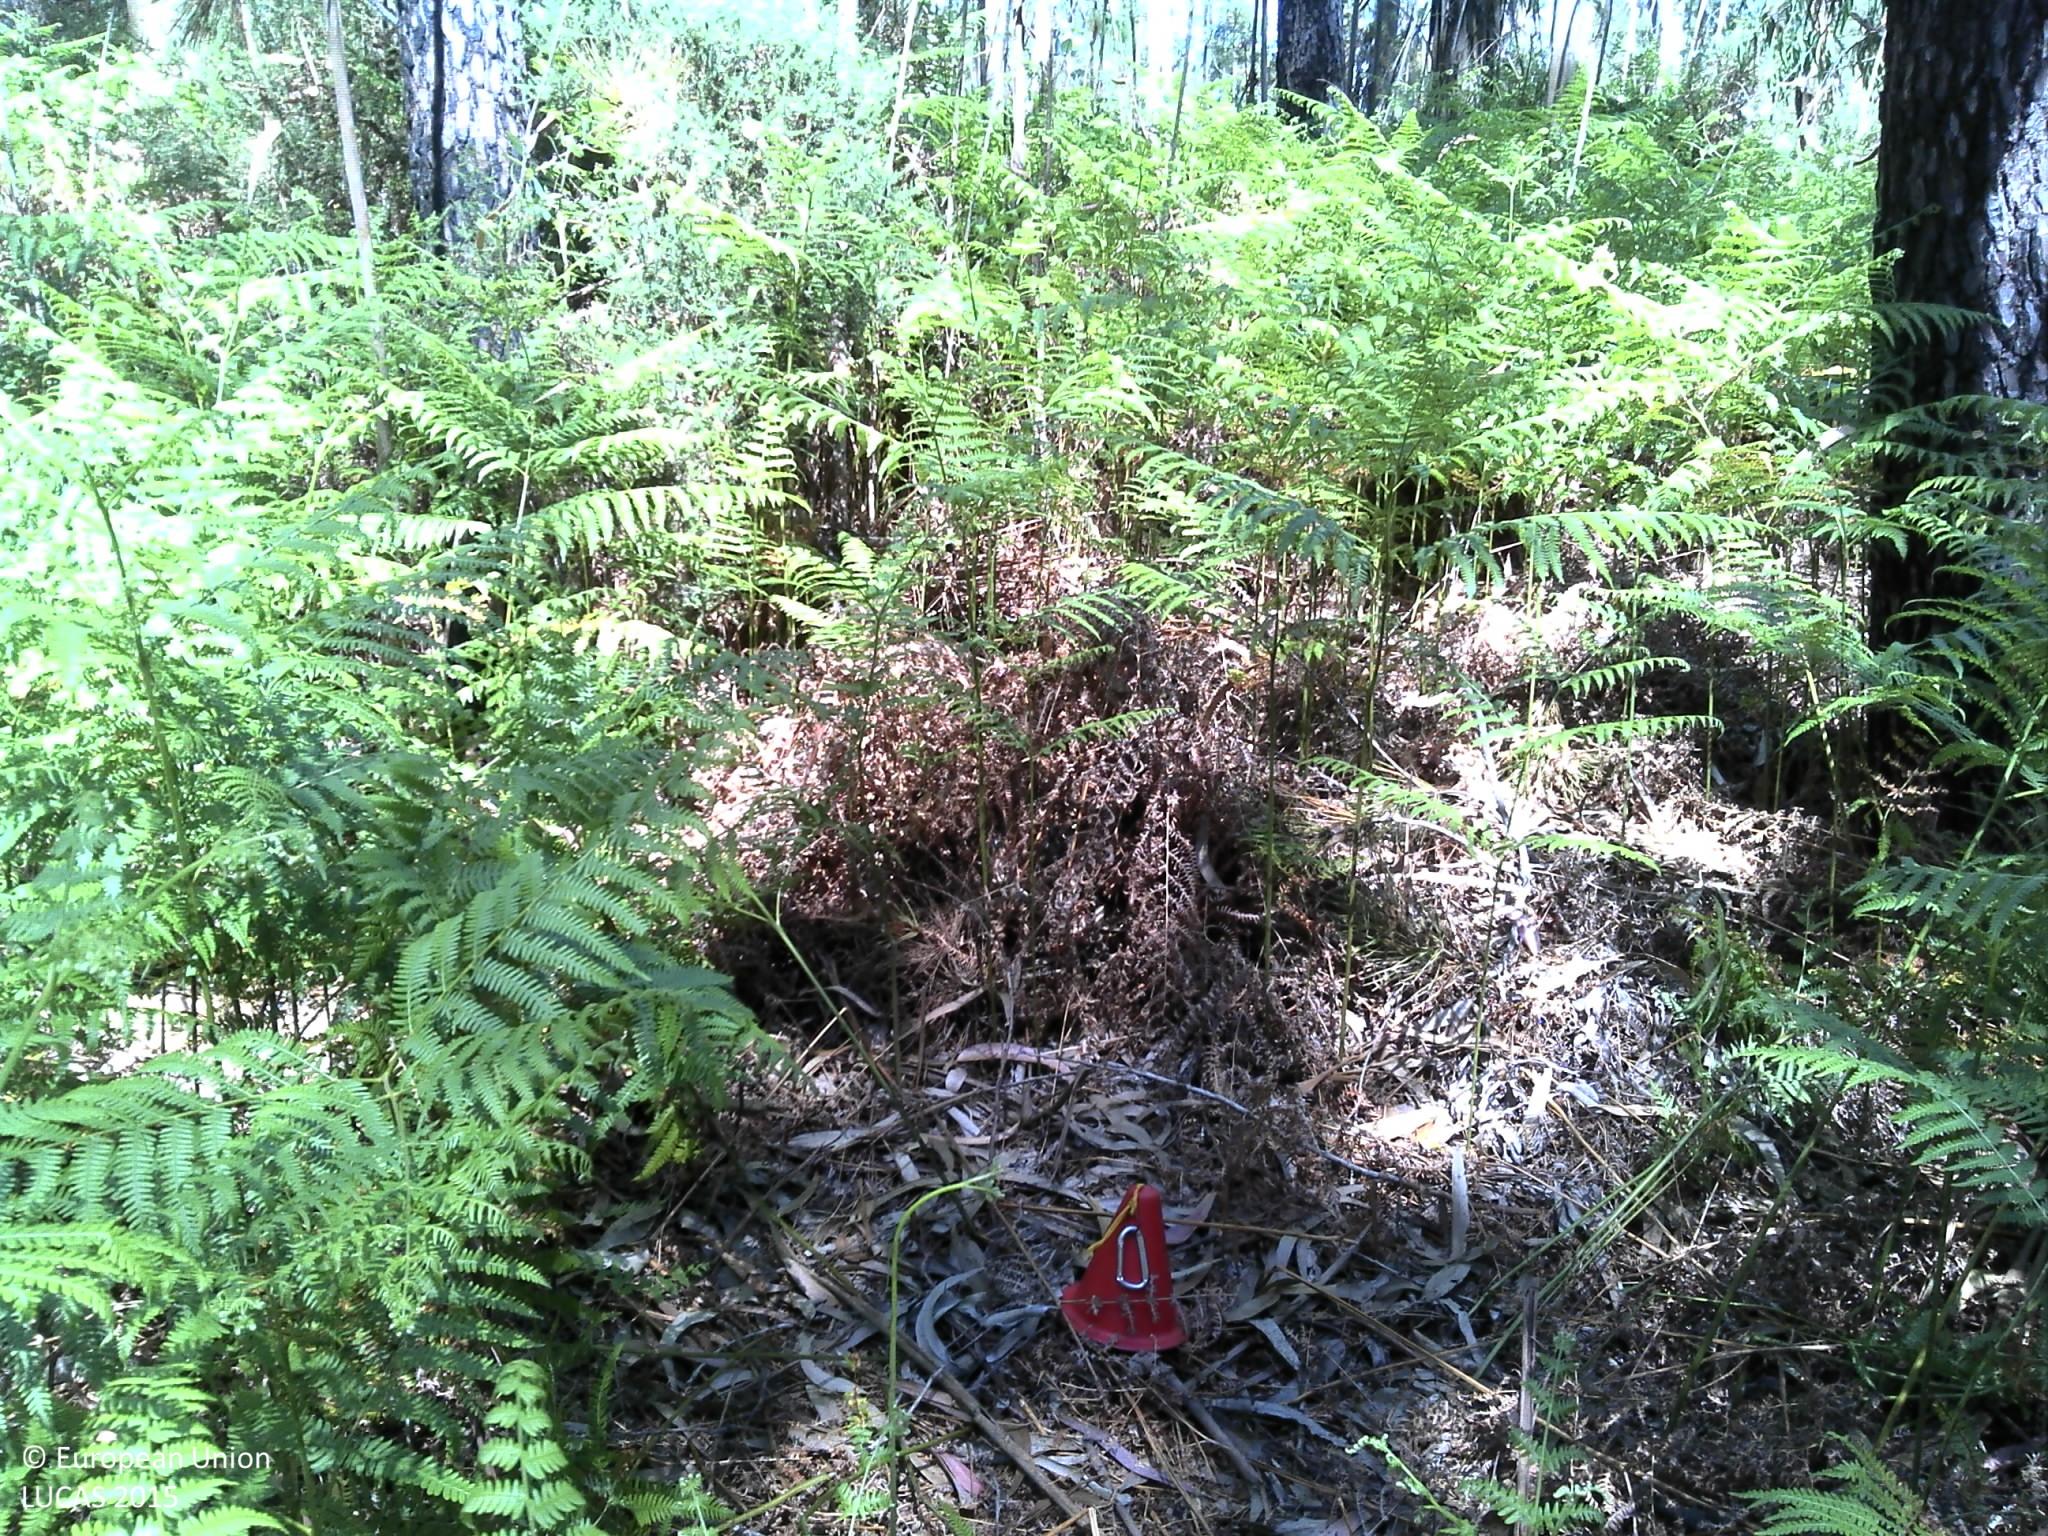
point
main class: Woodland
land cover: Broadleaved woodland
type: exotic forest
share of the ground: 50 - 75 %
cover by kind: broadleaved forest trees 65 %, shrubs 30 %, coniferous forest trees 5 %
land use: Forestry
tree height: > 5 m
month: May
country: PT
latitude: 41.6713
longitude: -8.5982
